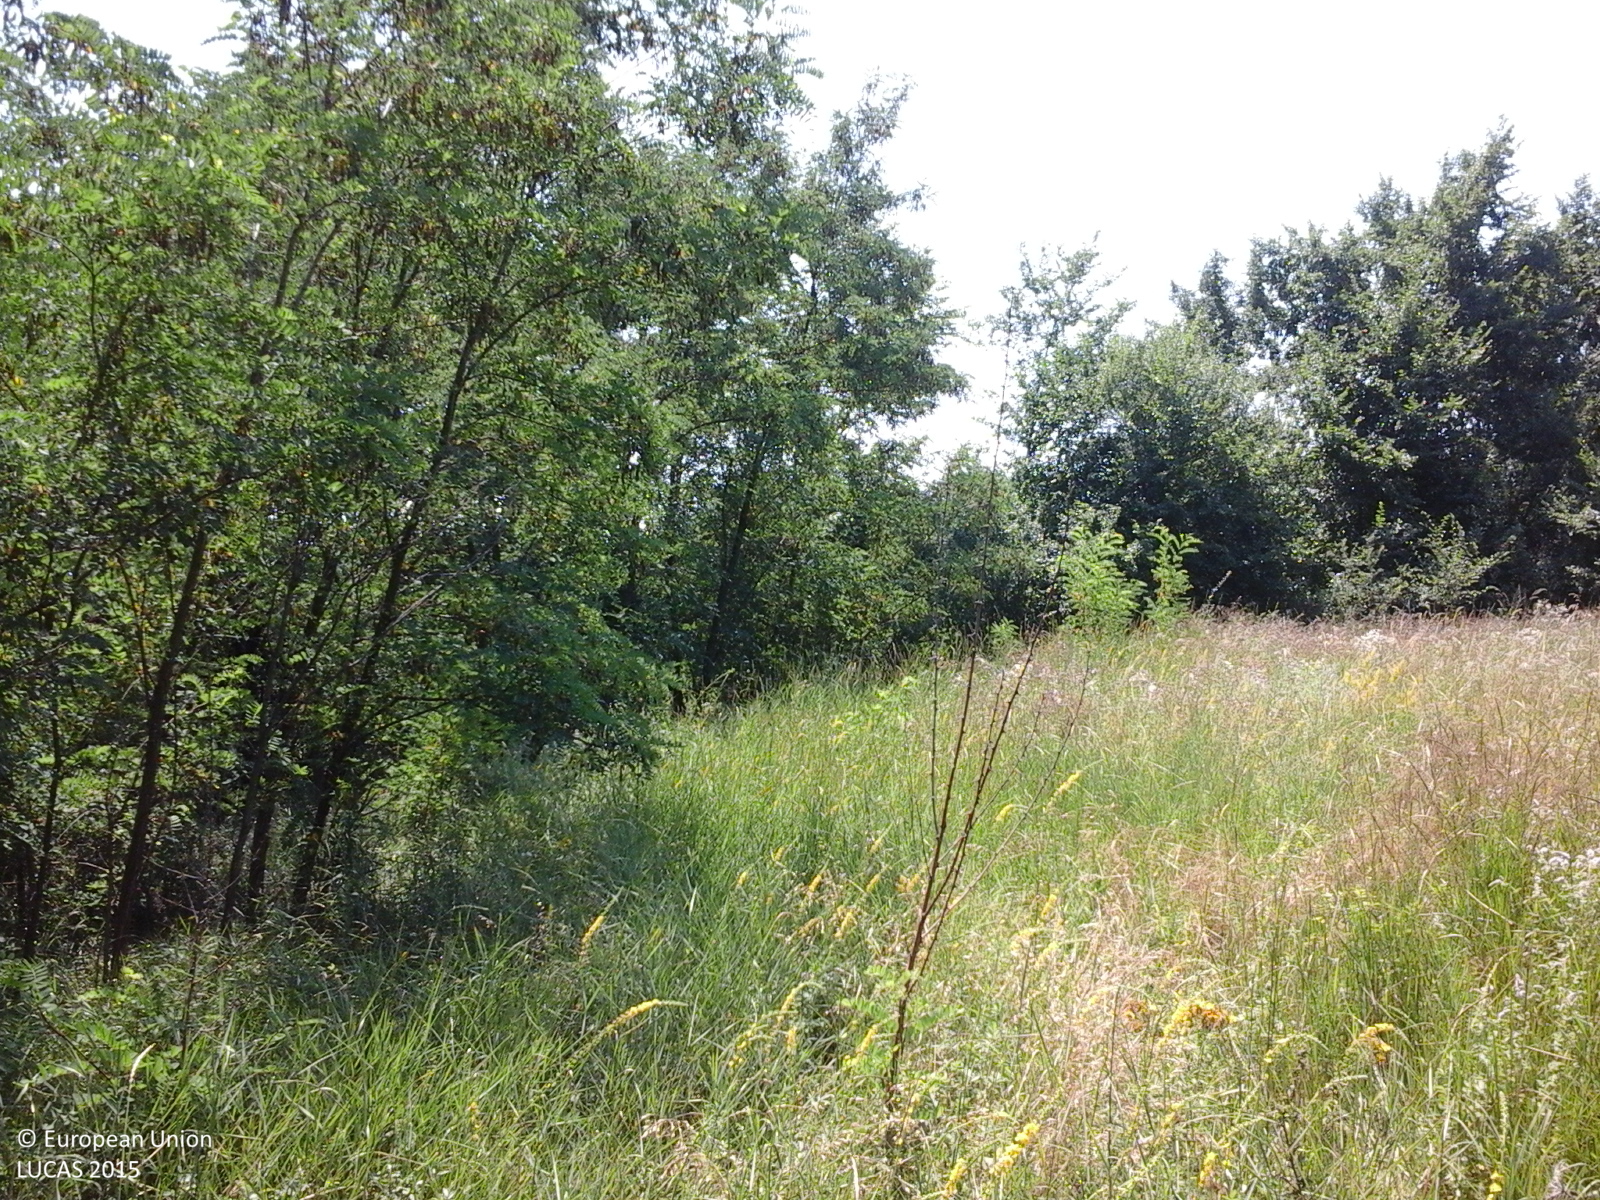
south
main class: Woodland
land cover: Broadleaved woodland
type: thermophilous deciduous forest
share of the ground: > 75 %
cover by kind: broadleaved forest trees 85 %, herbaceous plants 10 %, shrubs 5 %
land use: Forestry
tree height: > 5 m
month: July
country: RO
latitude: 44.6881
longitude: 24.5718
